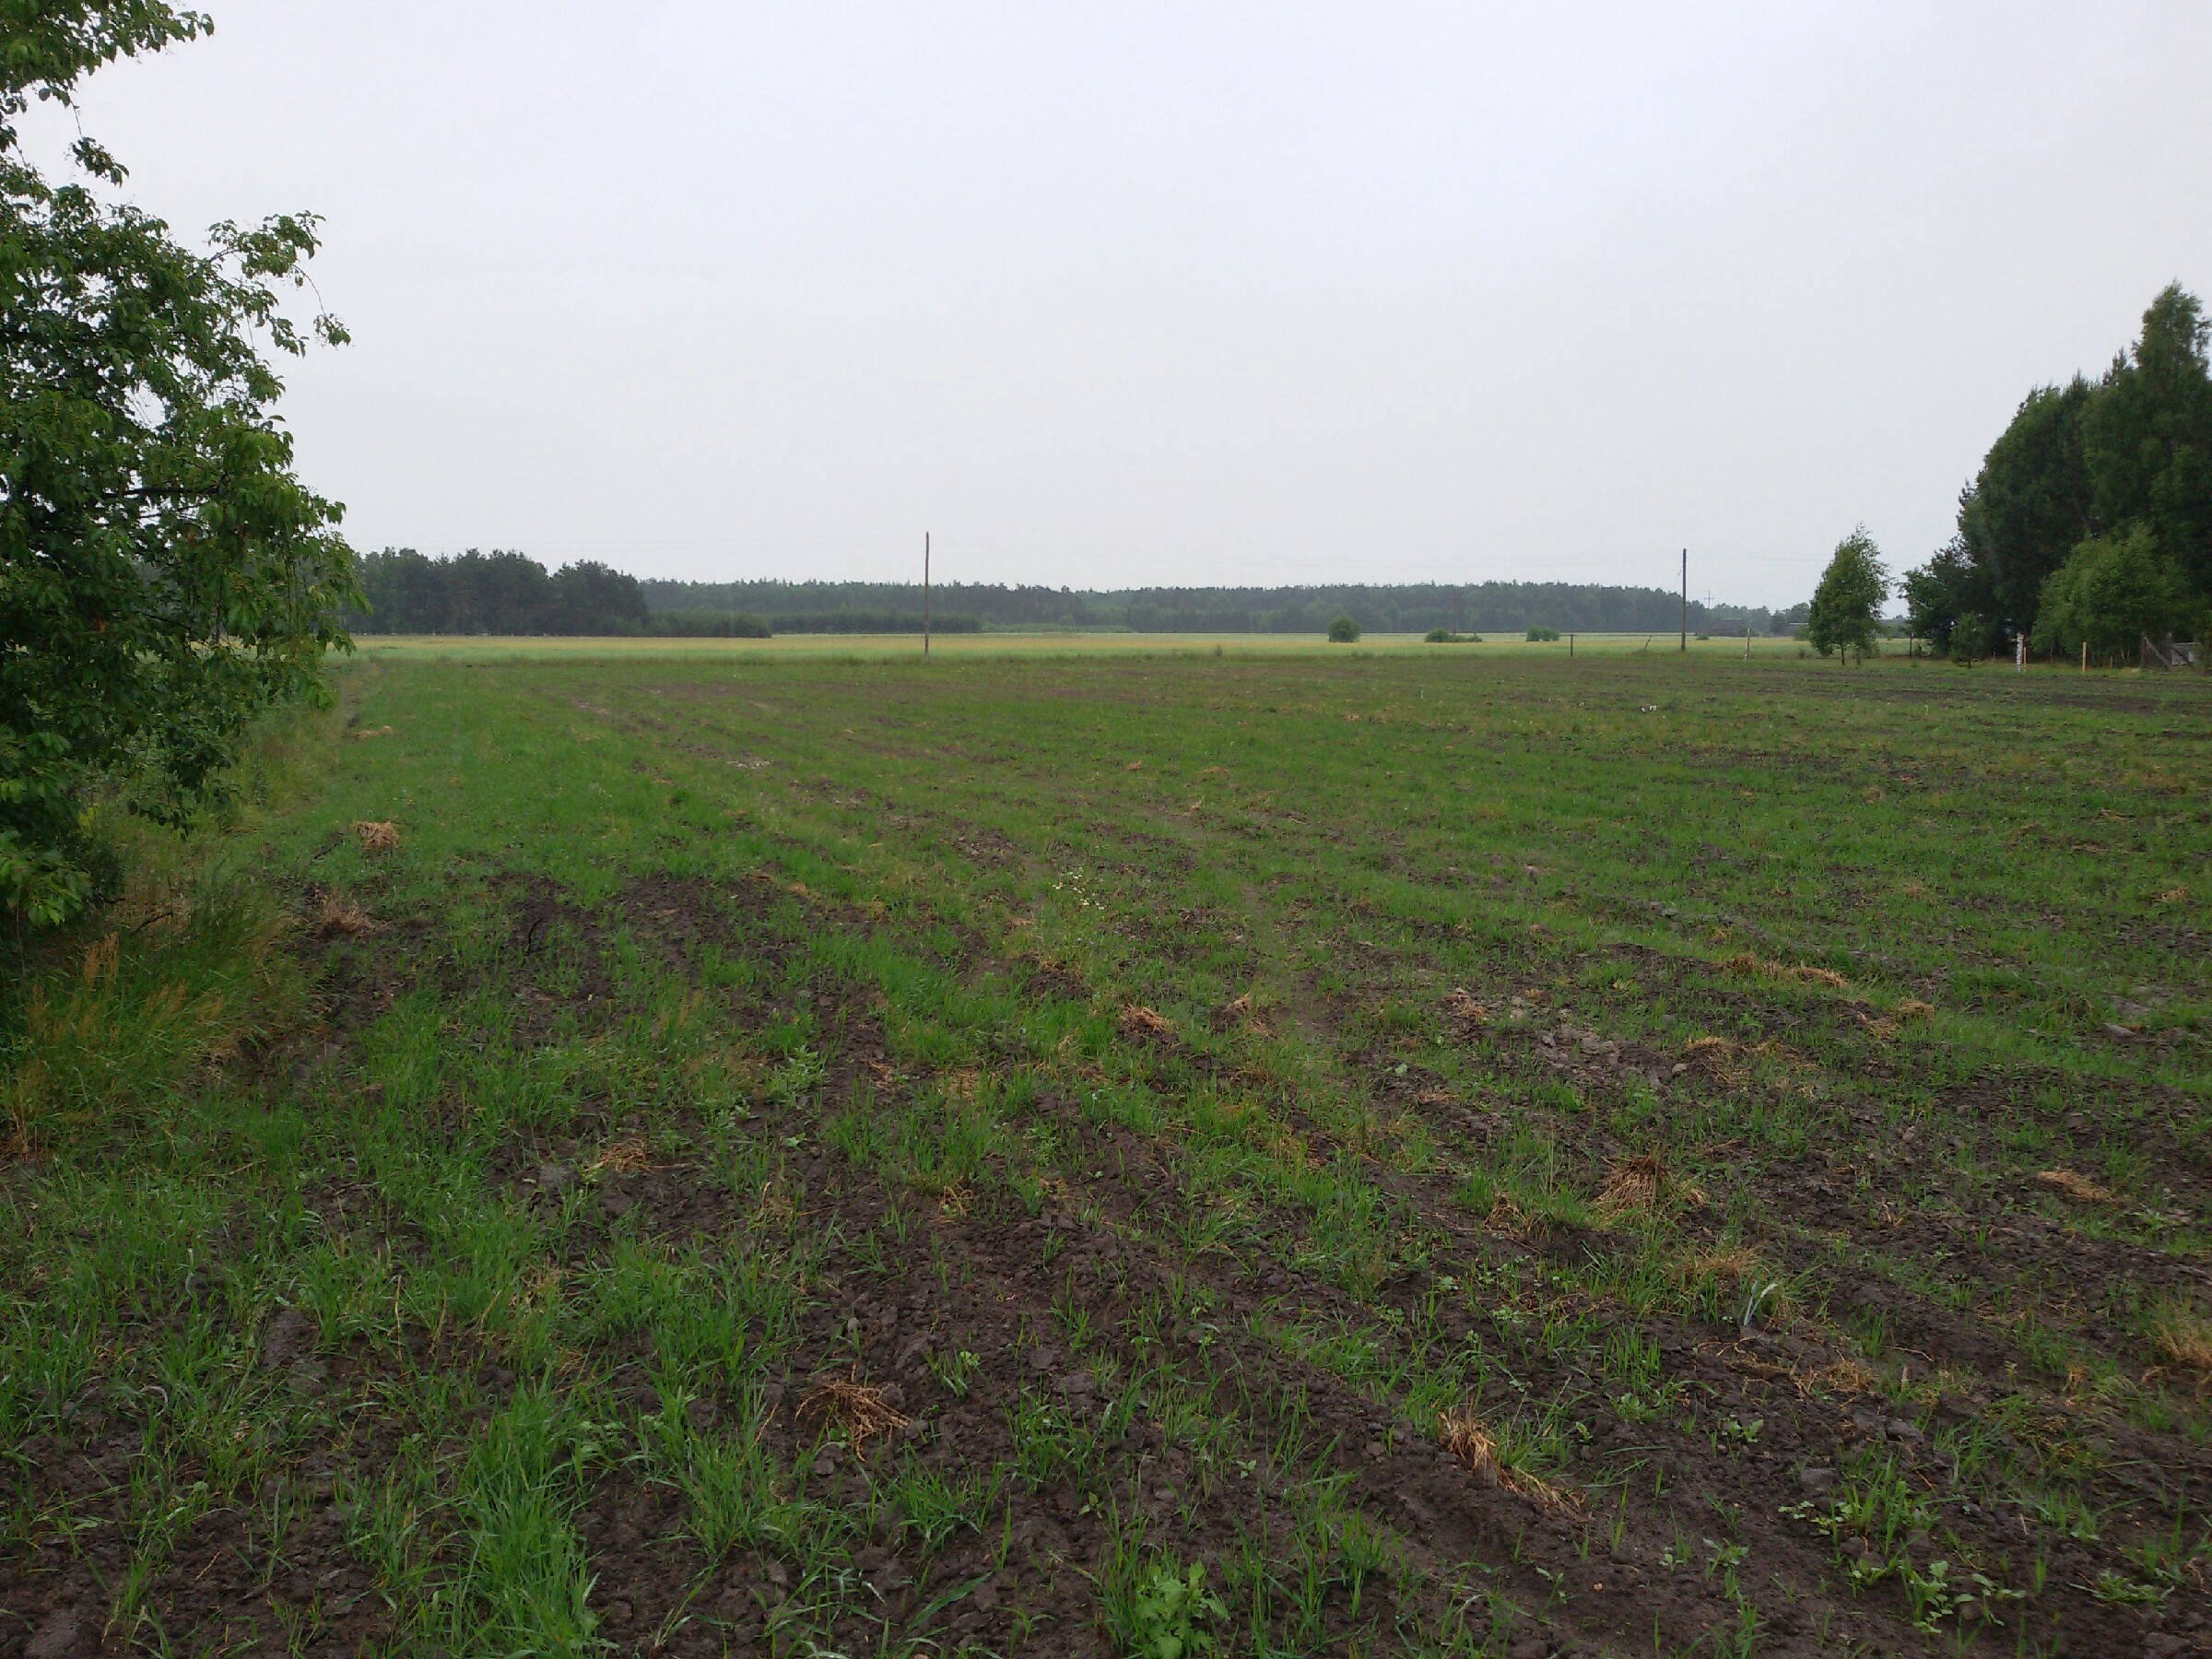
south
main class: Cropland
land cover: Potatoes
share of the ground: > 75 %
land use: Agriculture (excluding fallow land and kitchen gardens)
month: June
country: PL
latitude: 51.9940
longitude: 22.9338
